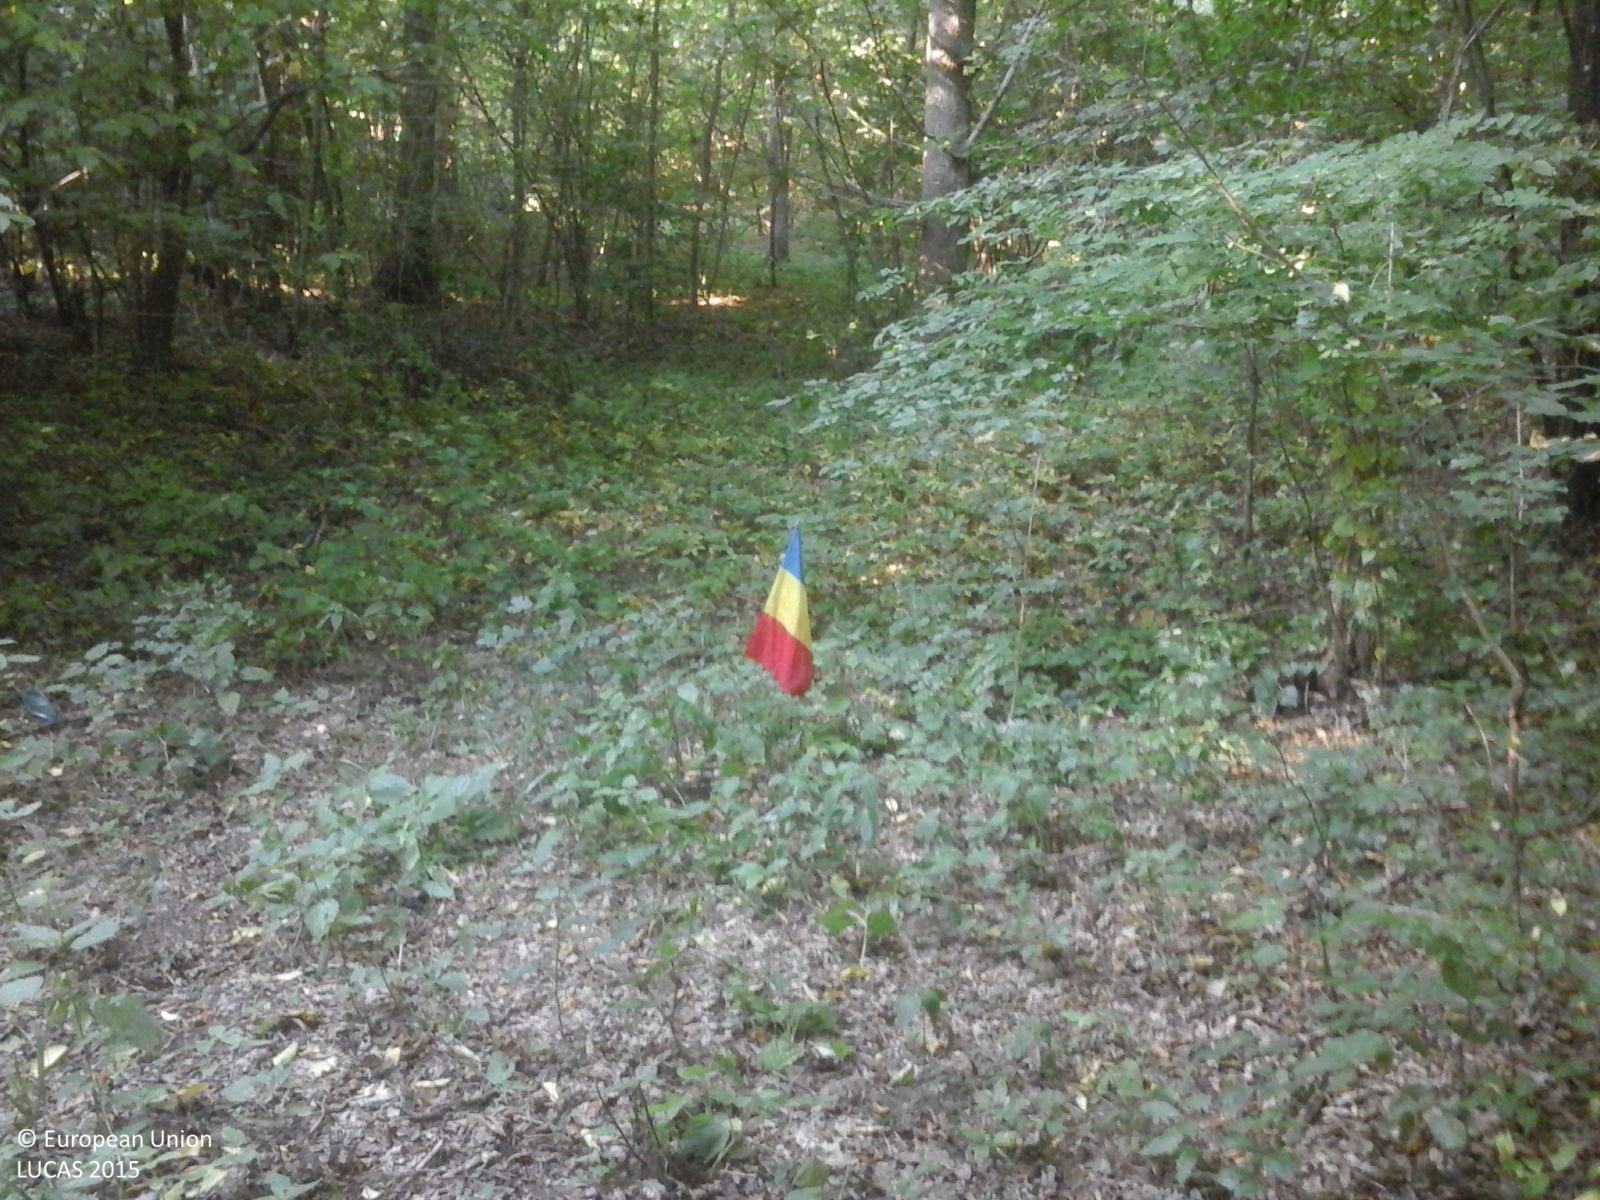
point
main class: Woodland
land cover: Broadleaved woodland
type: beech forest
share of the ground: > 75 %
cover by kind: broadleaved forest trees 95 %, herbaceous plants 5 %
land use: Forestry
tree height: > 5 m
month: July
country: RO
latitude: 45.0126
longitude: 24.7356
